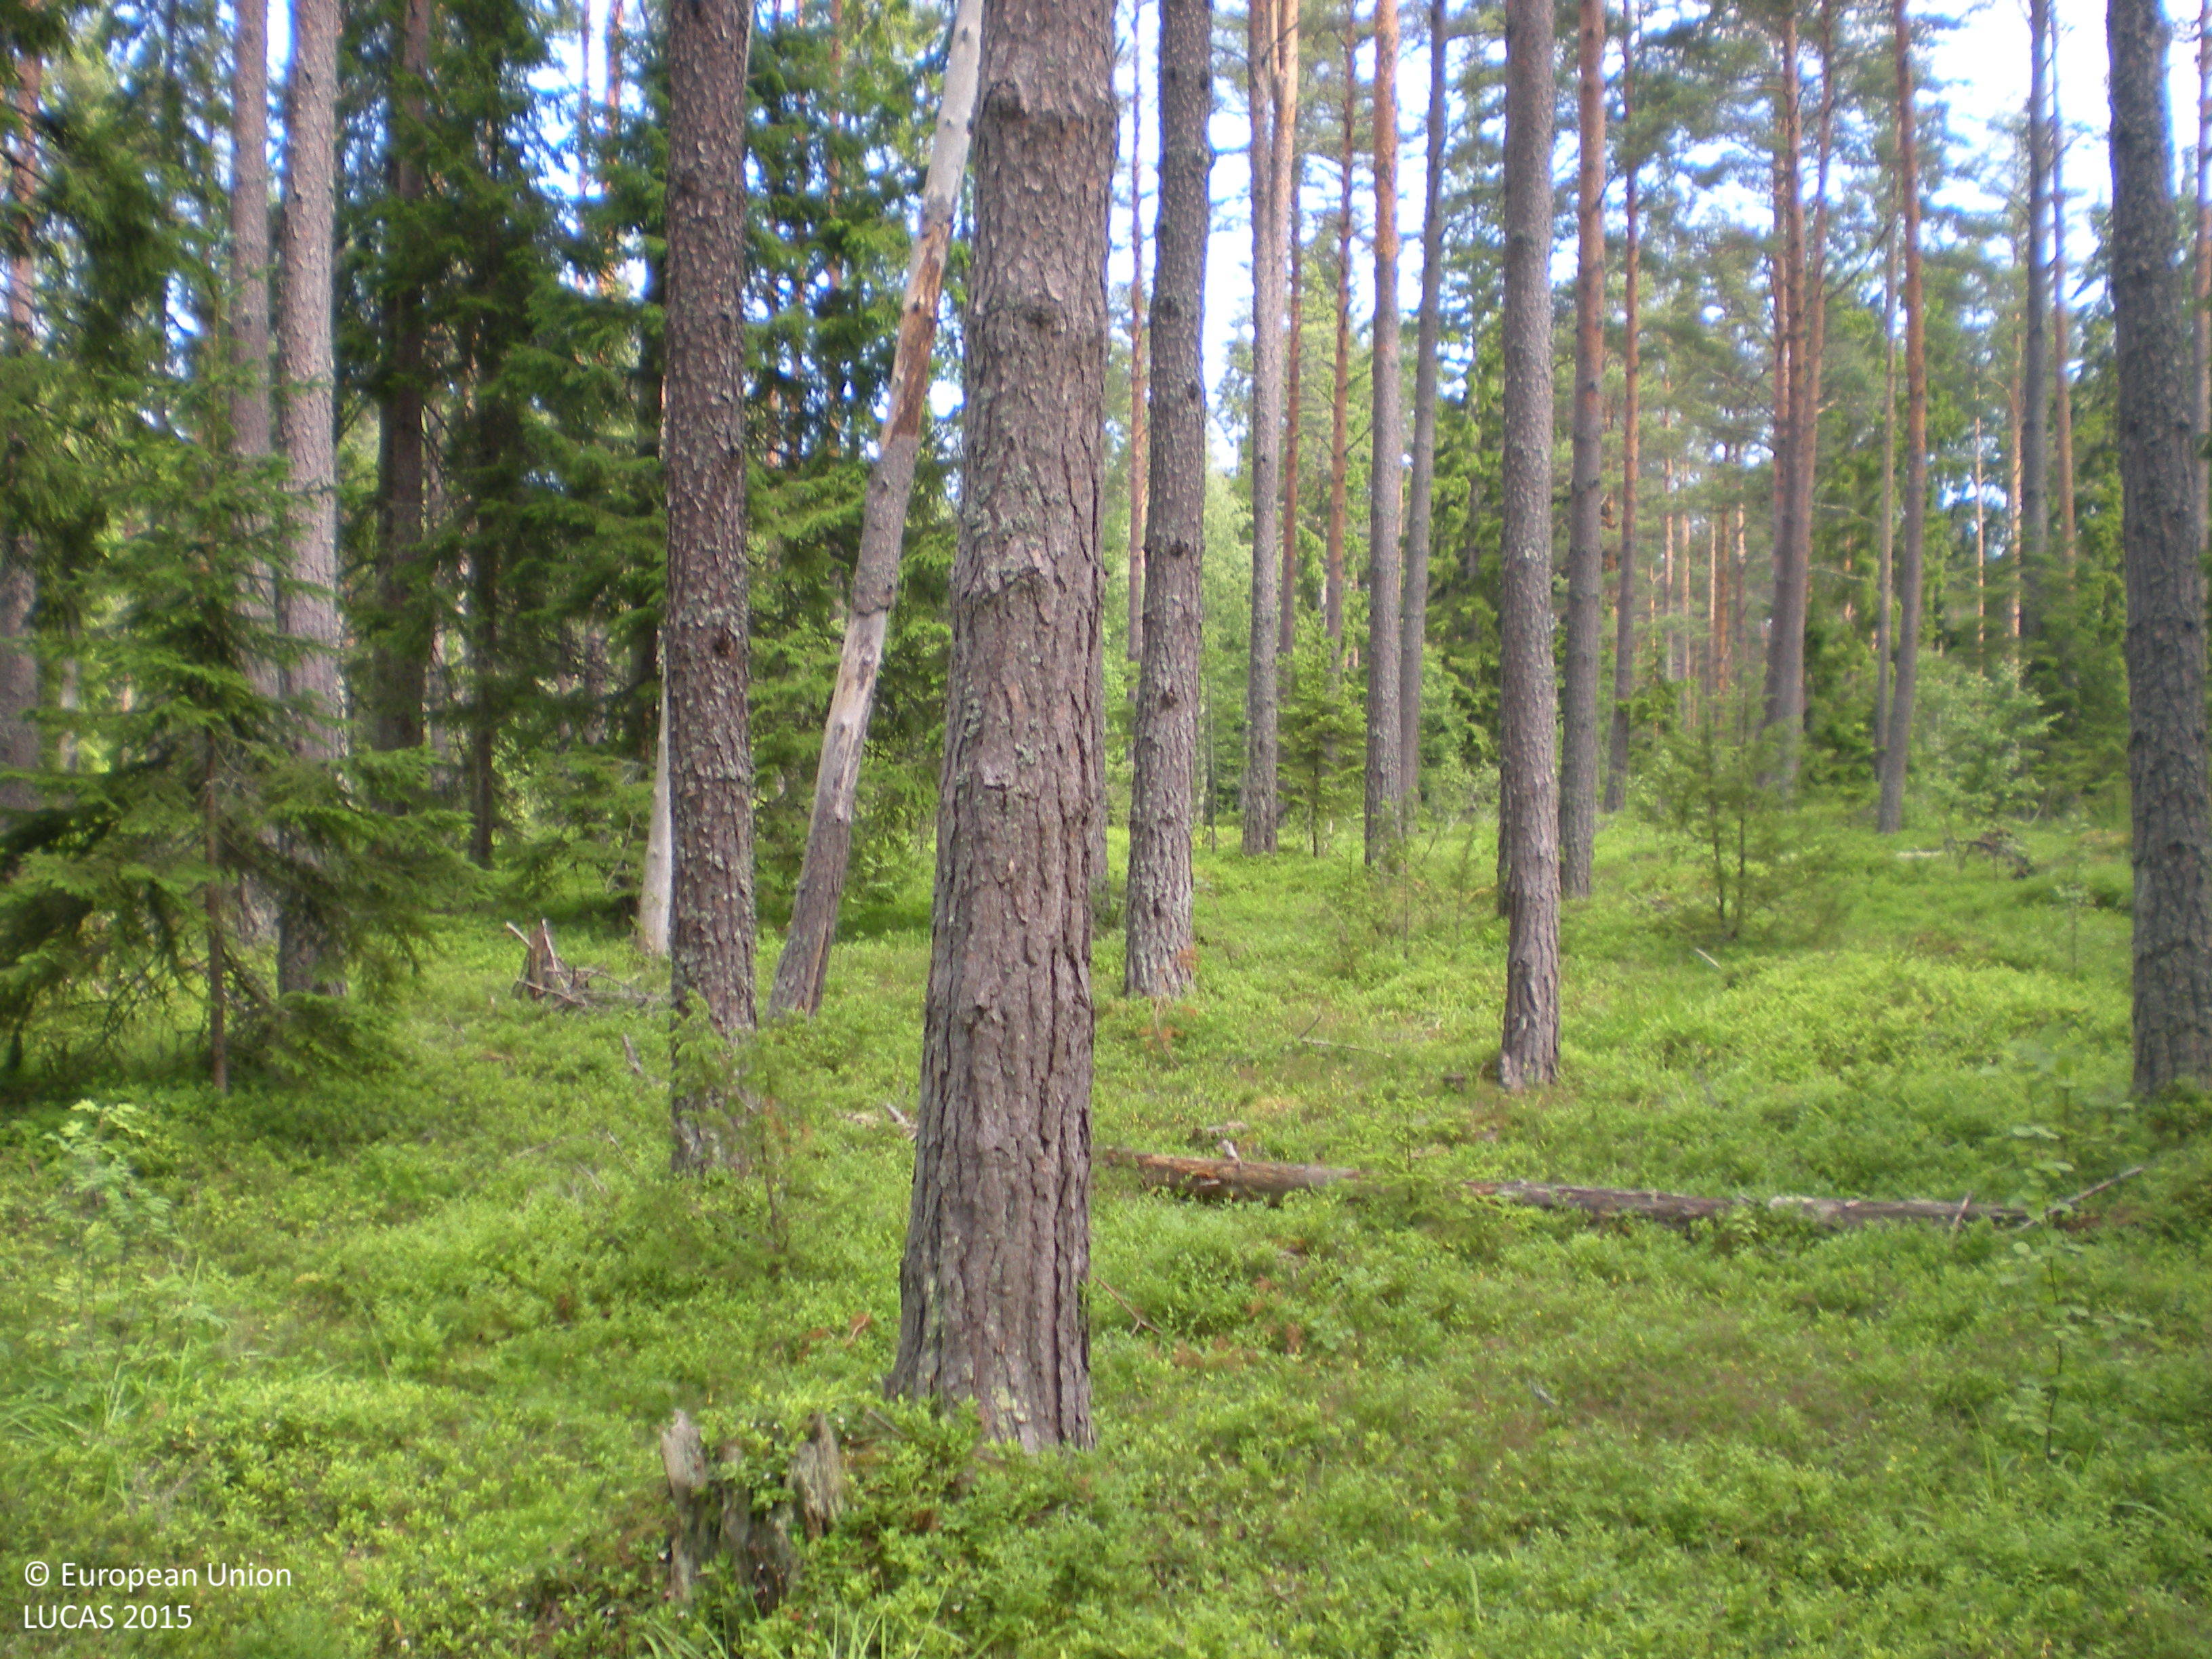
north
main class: Woodland
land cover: Pine dominated coniferous woodland
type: boreal forest
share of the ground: 50 - 75 %
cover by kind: coniferous forest trees 70 %, shrubs 20 %, herbaceous plants 5 %, lichens and mosses 5 %
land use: Forestry
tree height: > 5 m
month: June
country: SE
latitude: 60.4577
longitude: 18.0477
